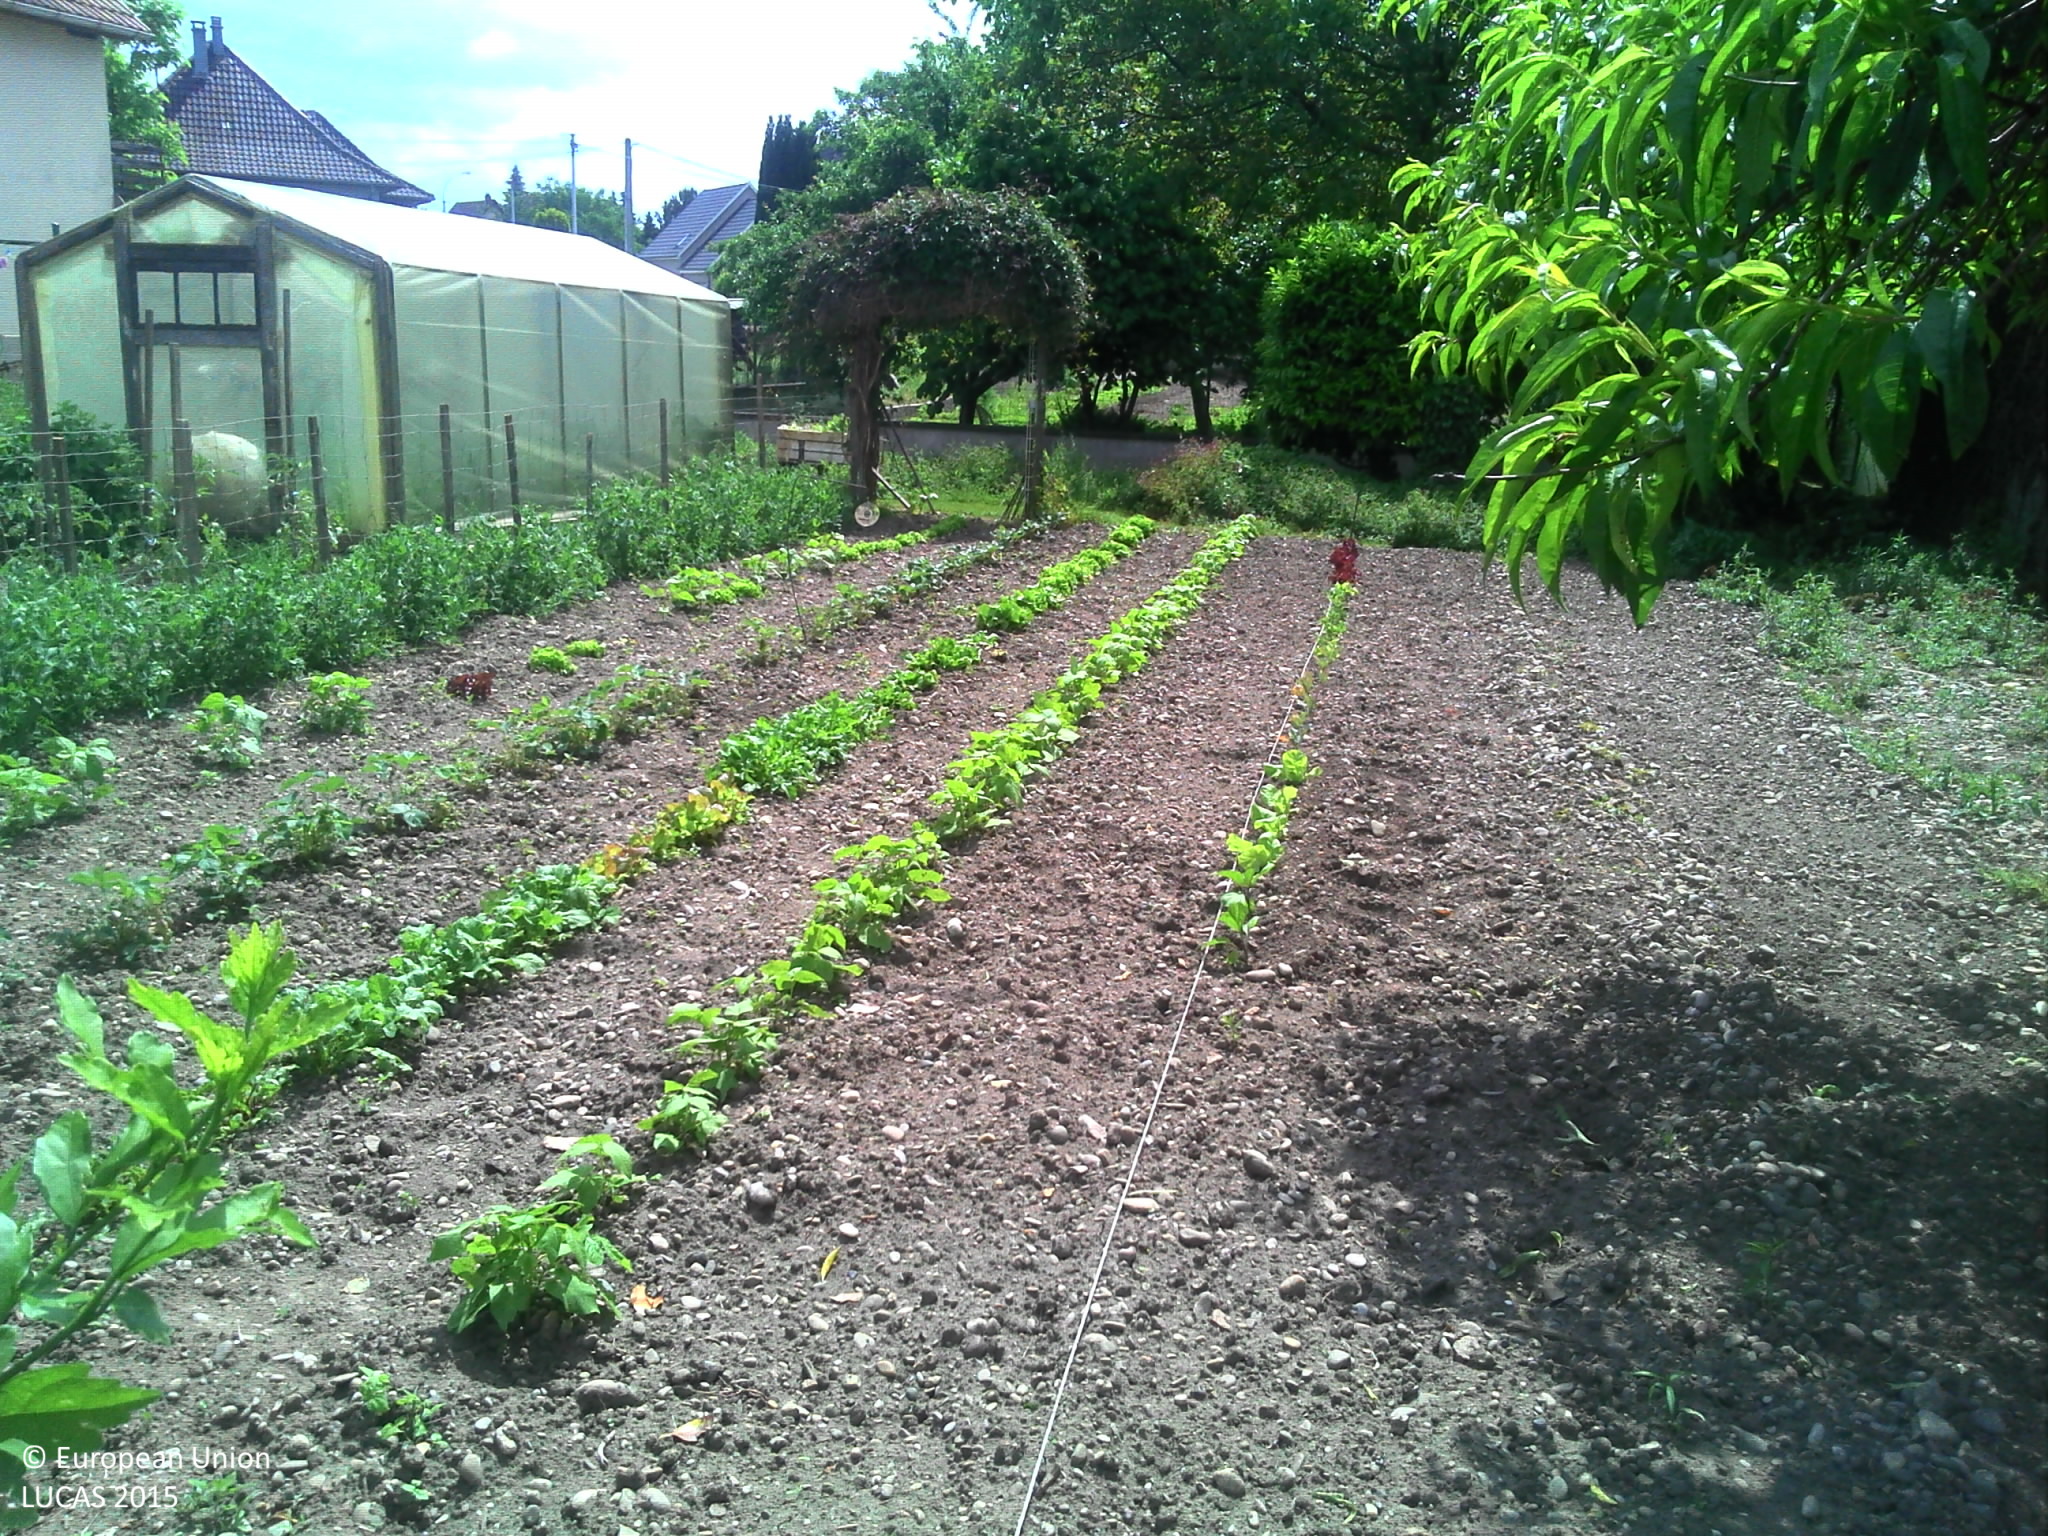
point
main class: Cropland
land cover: Other fresh vegetables
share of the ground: > 75 %
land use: Kitchen garden
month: May
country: FR
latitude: 48.2338
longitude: 7.6180
